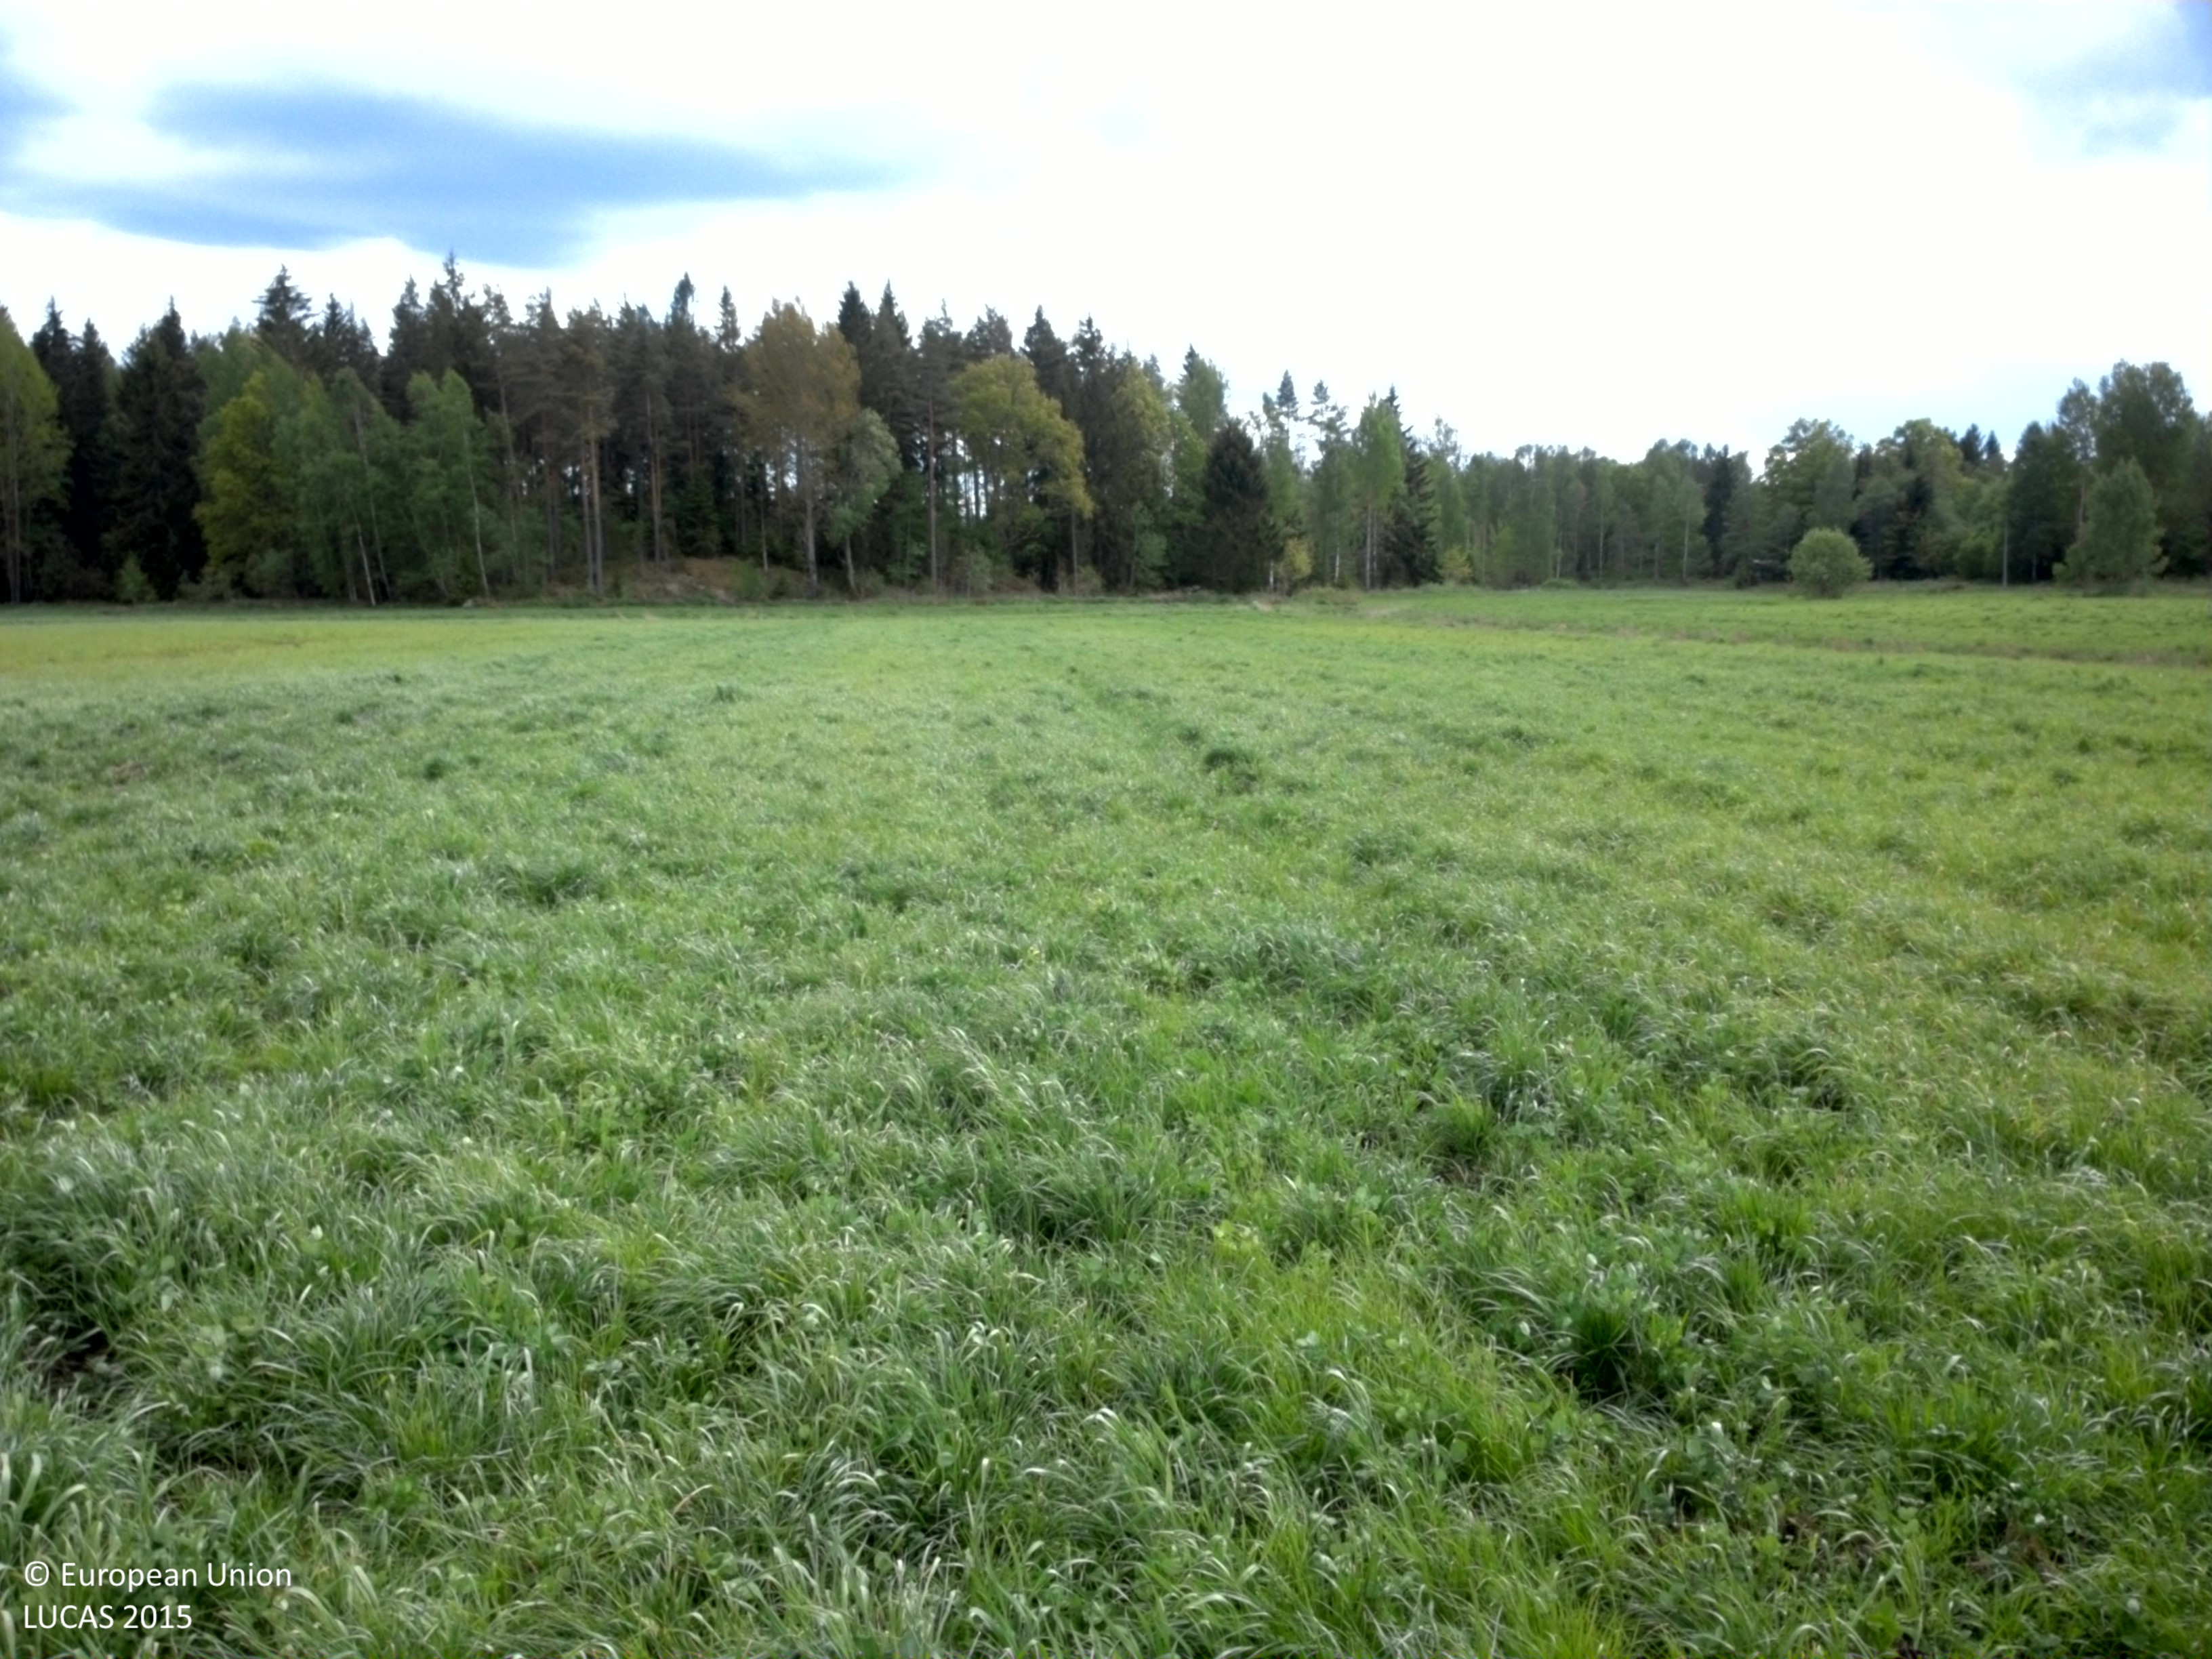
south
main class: Grassland
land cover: Grassland without tree/shrub cover
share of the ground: > 75 %
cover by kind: herbaceous plants 100 %
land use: Agriculture (excluding fallow land and kitchen gardens)
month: May
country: SE
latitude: 57.2968
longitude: 15.8893
